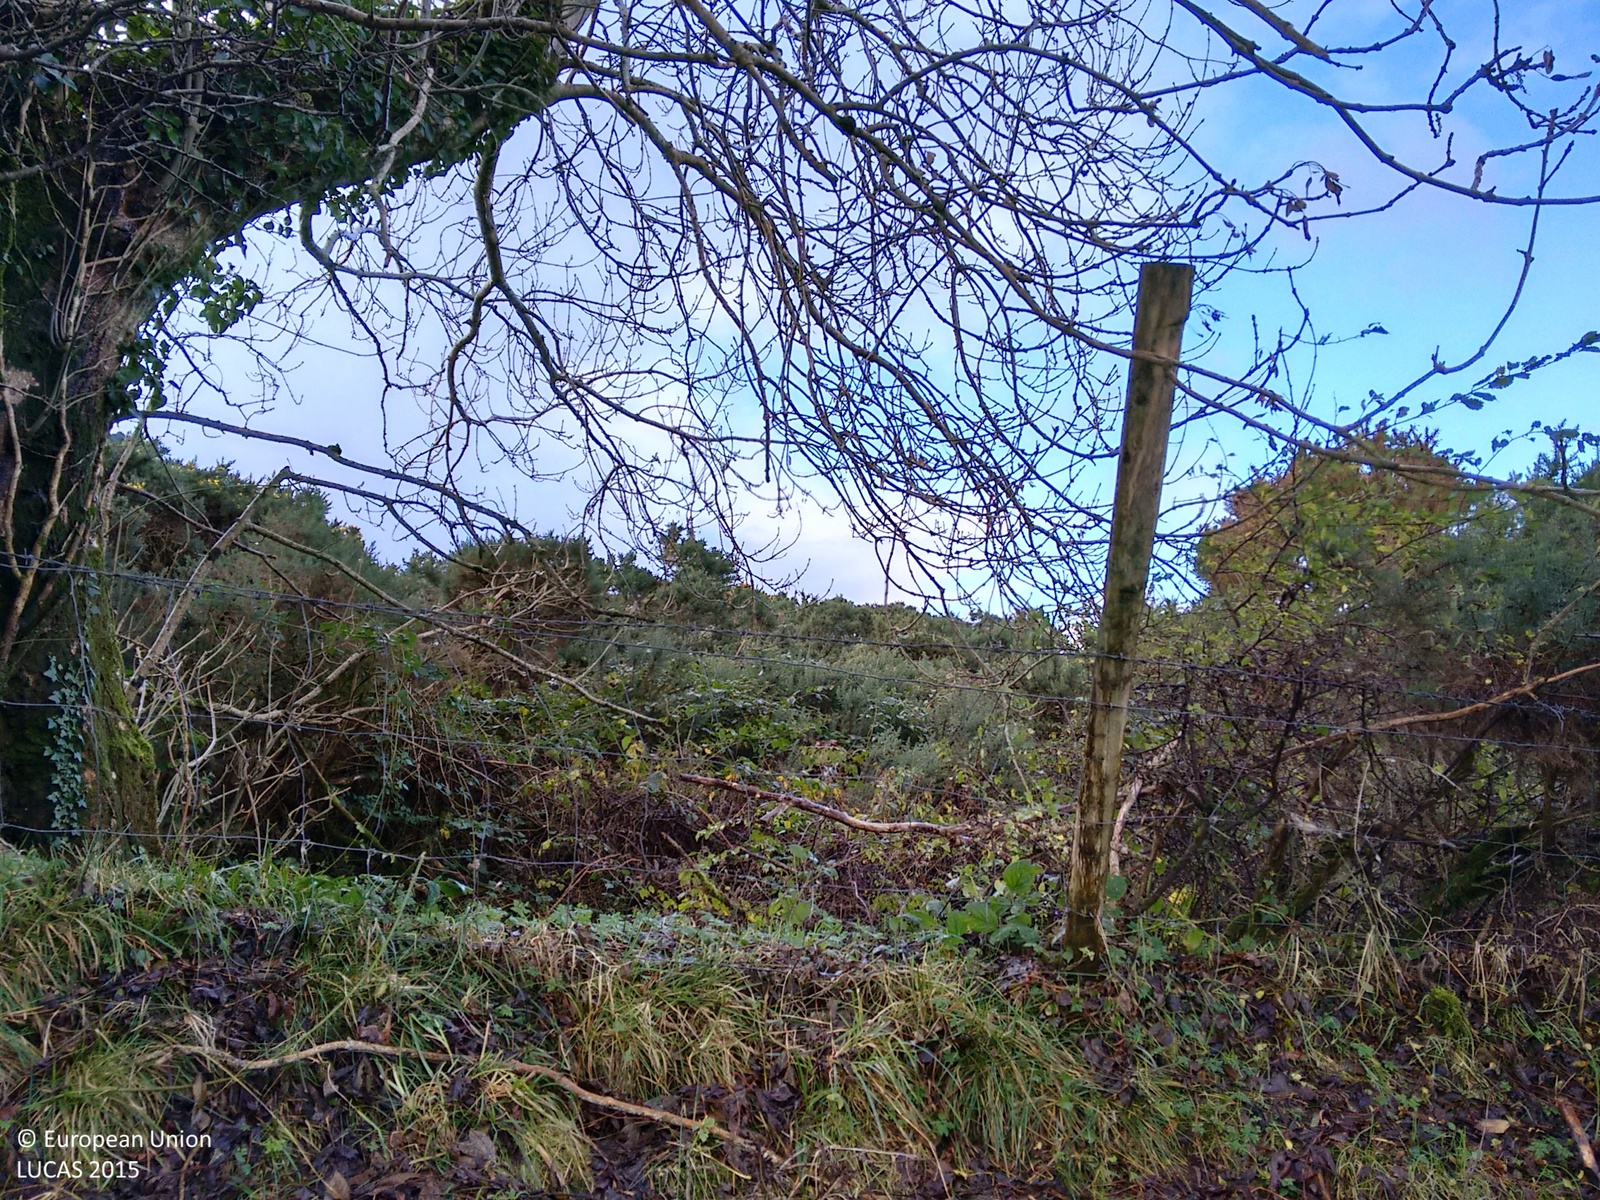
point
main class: Shrubland
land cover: Shrubland without tree cover
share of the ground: > 75 %
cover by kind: herbaceous plants 80 %, shrubs 20 %
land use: Agriculture (excluding fallow land and kitchen gardens)
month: November
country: IE
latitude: 54.6553
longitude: -8.1424
